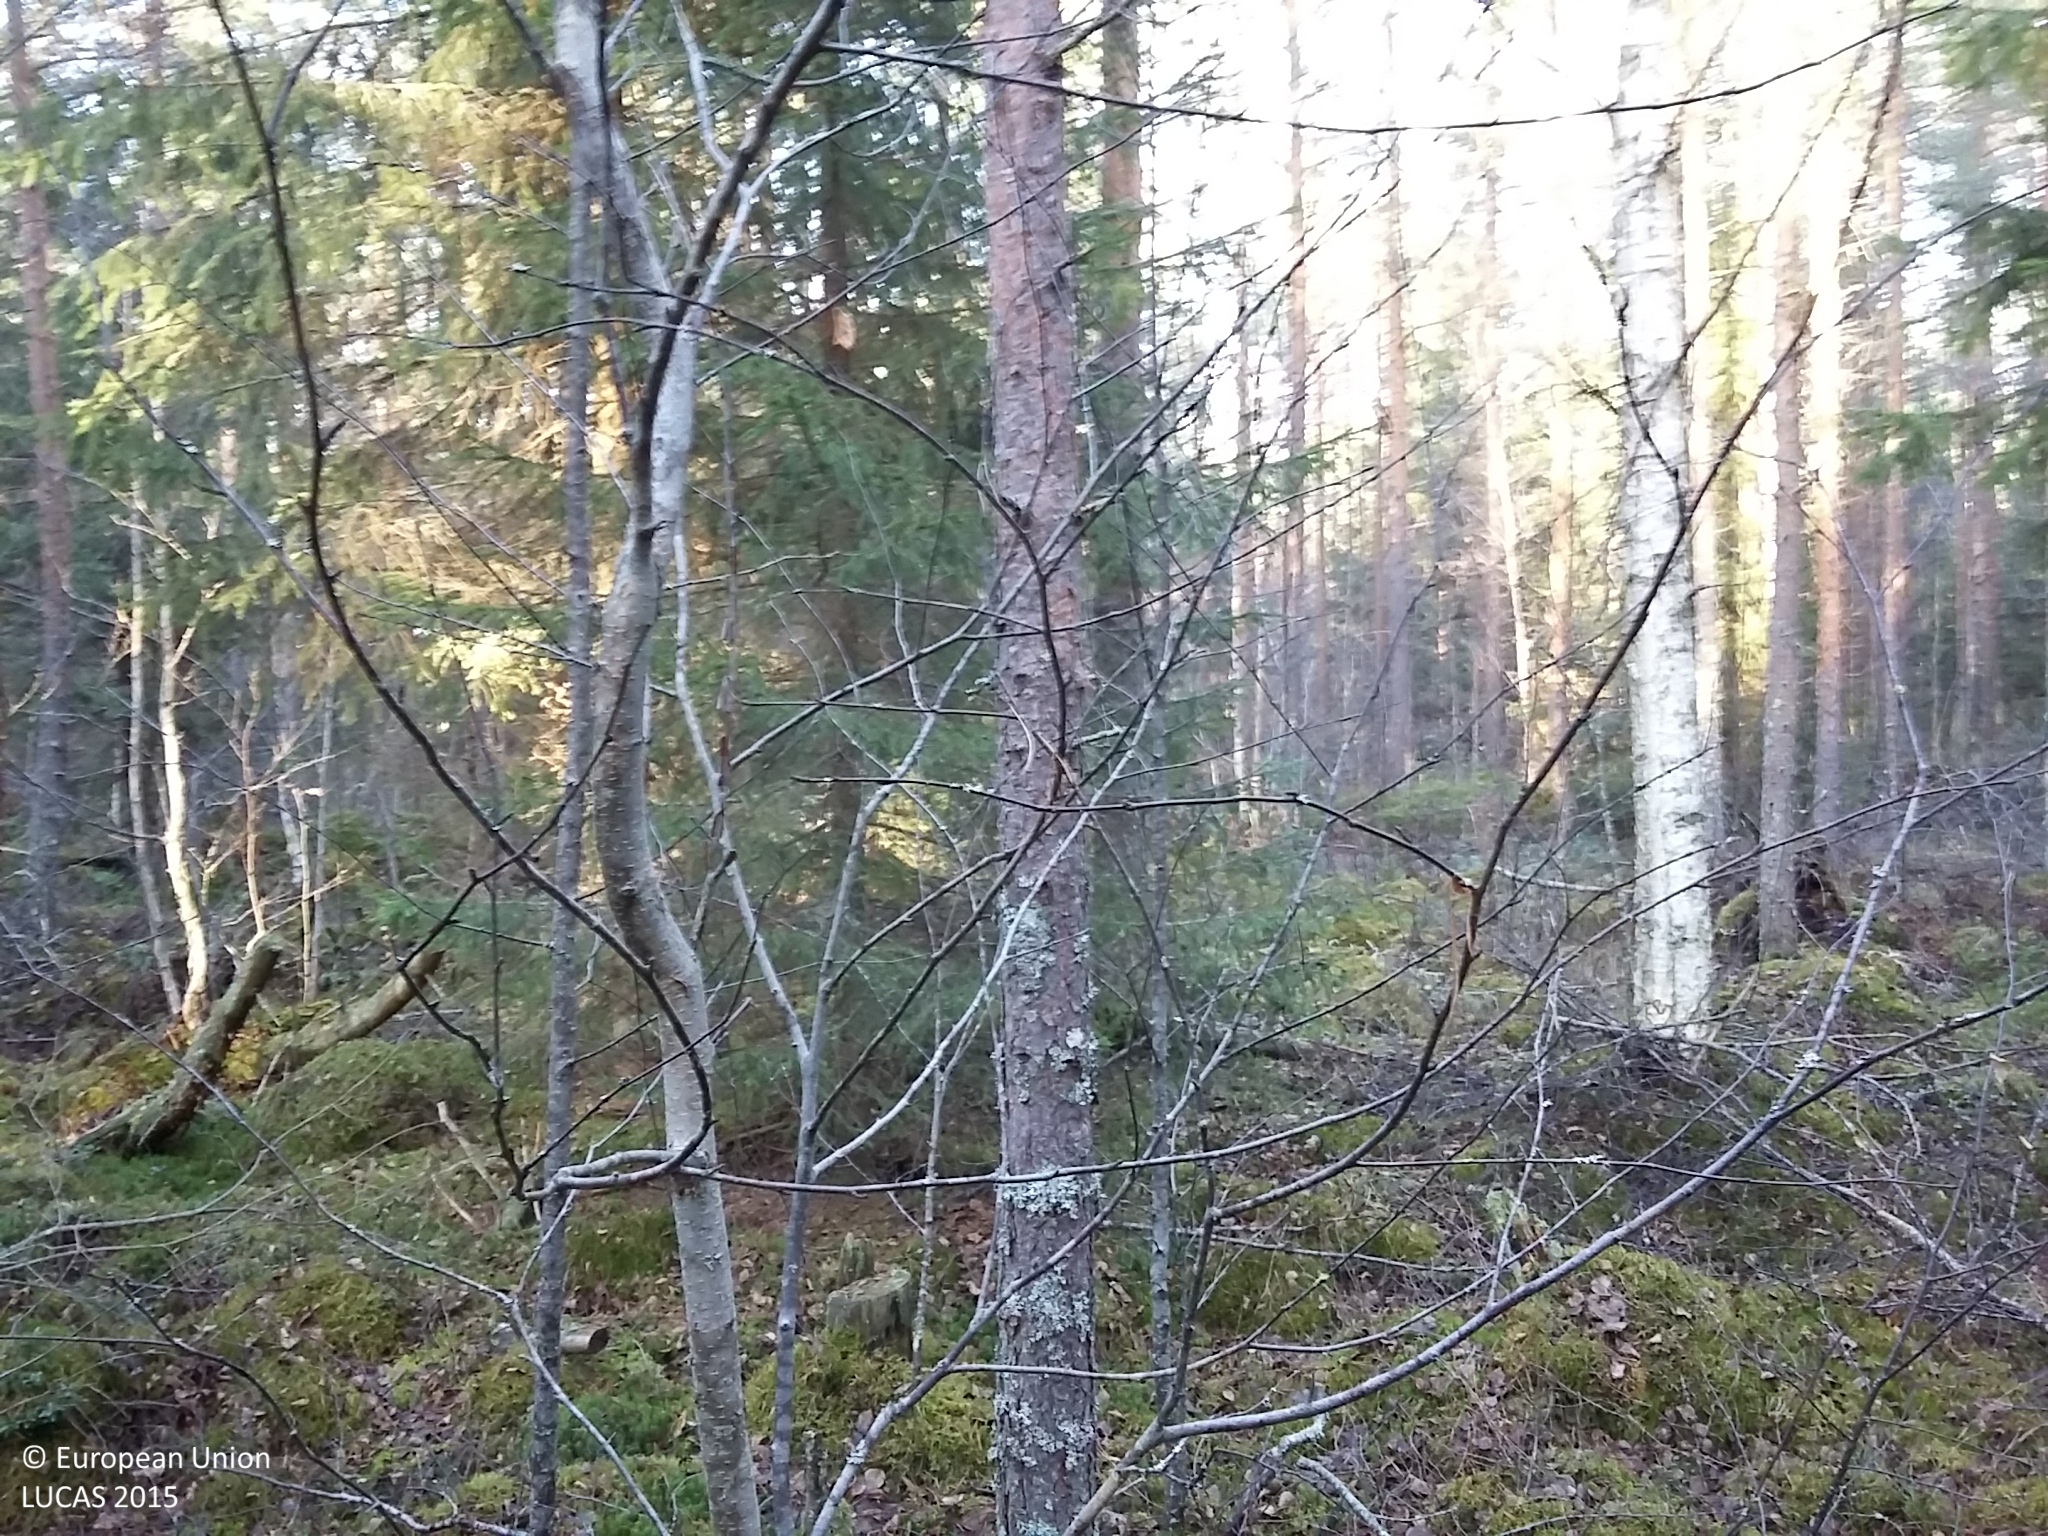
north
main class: Woodland
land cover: Other coniferous woodland
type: boreal forest
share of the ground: > 75 %
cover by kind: coniferous forest trees 80 %, broadleaved forest trees 10 %, herbaceous plants 5 %, lichens and mosses 5 %
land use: Forestry
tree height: > 5 m
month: October
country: FI
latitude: 64.5928
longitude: 25.4839
